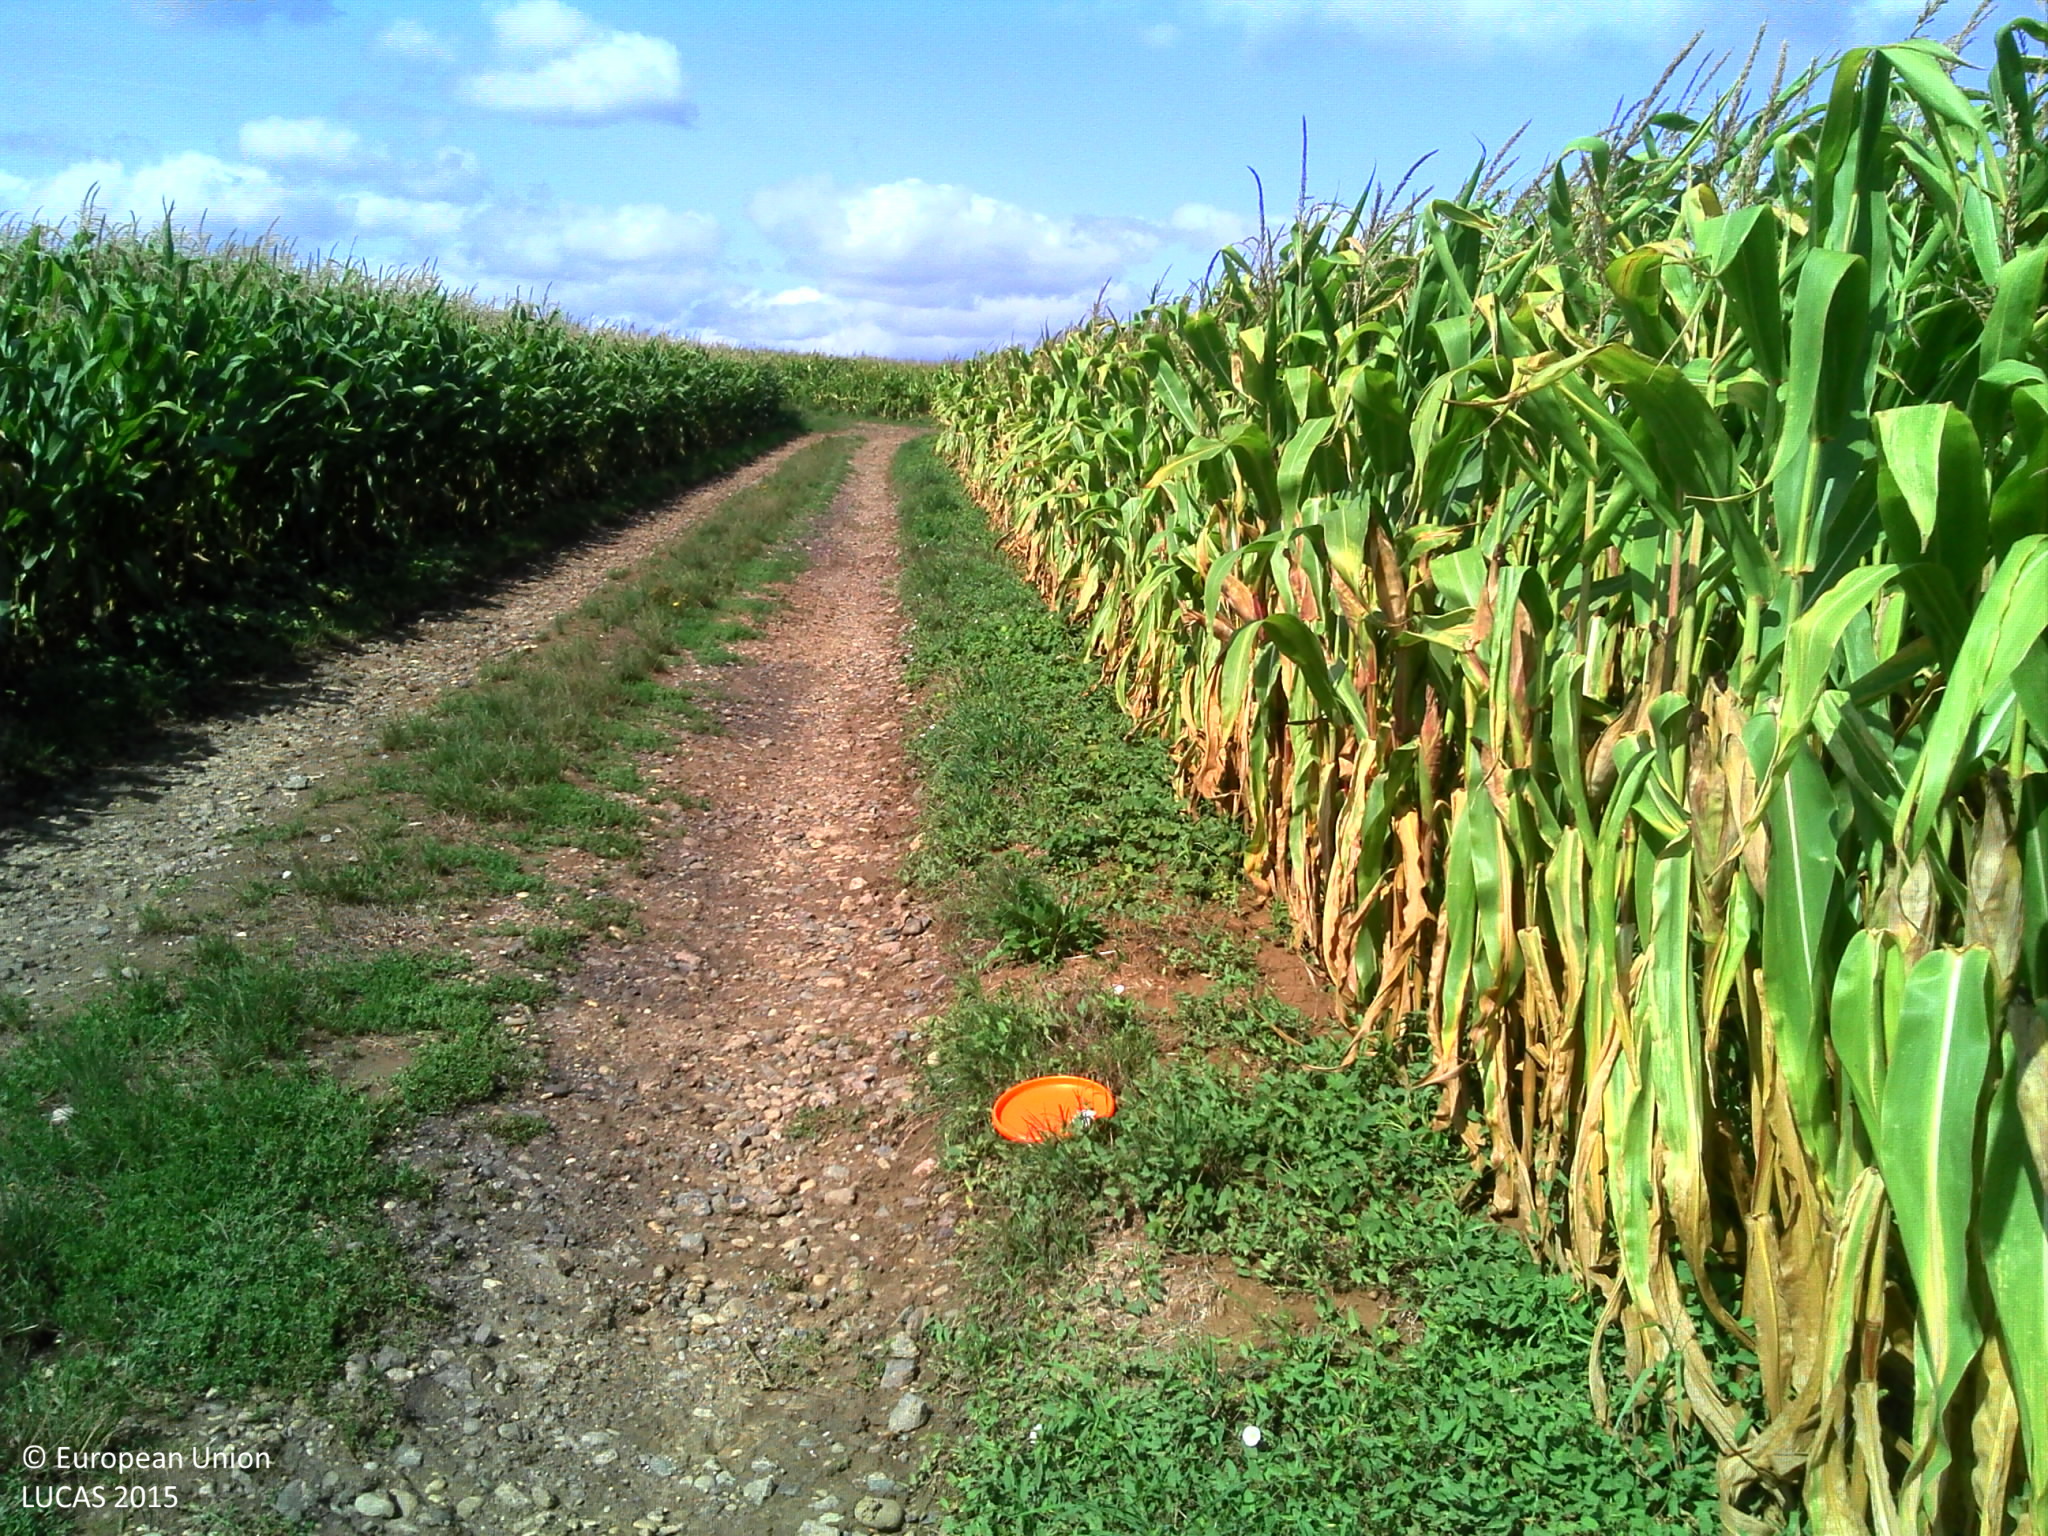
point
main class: Cropland
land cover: Maize
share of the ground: > 75 %
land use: Agriculture (excluding fallow land and kitchen gardens)
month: August
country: FR
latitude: 48.7745
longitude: 7.6466
